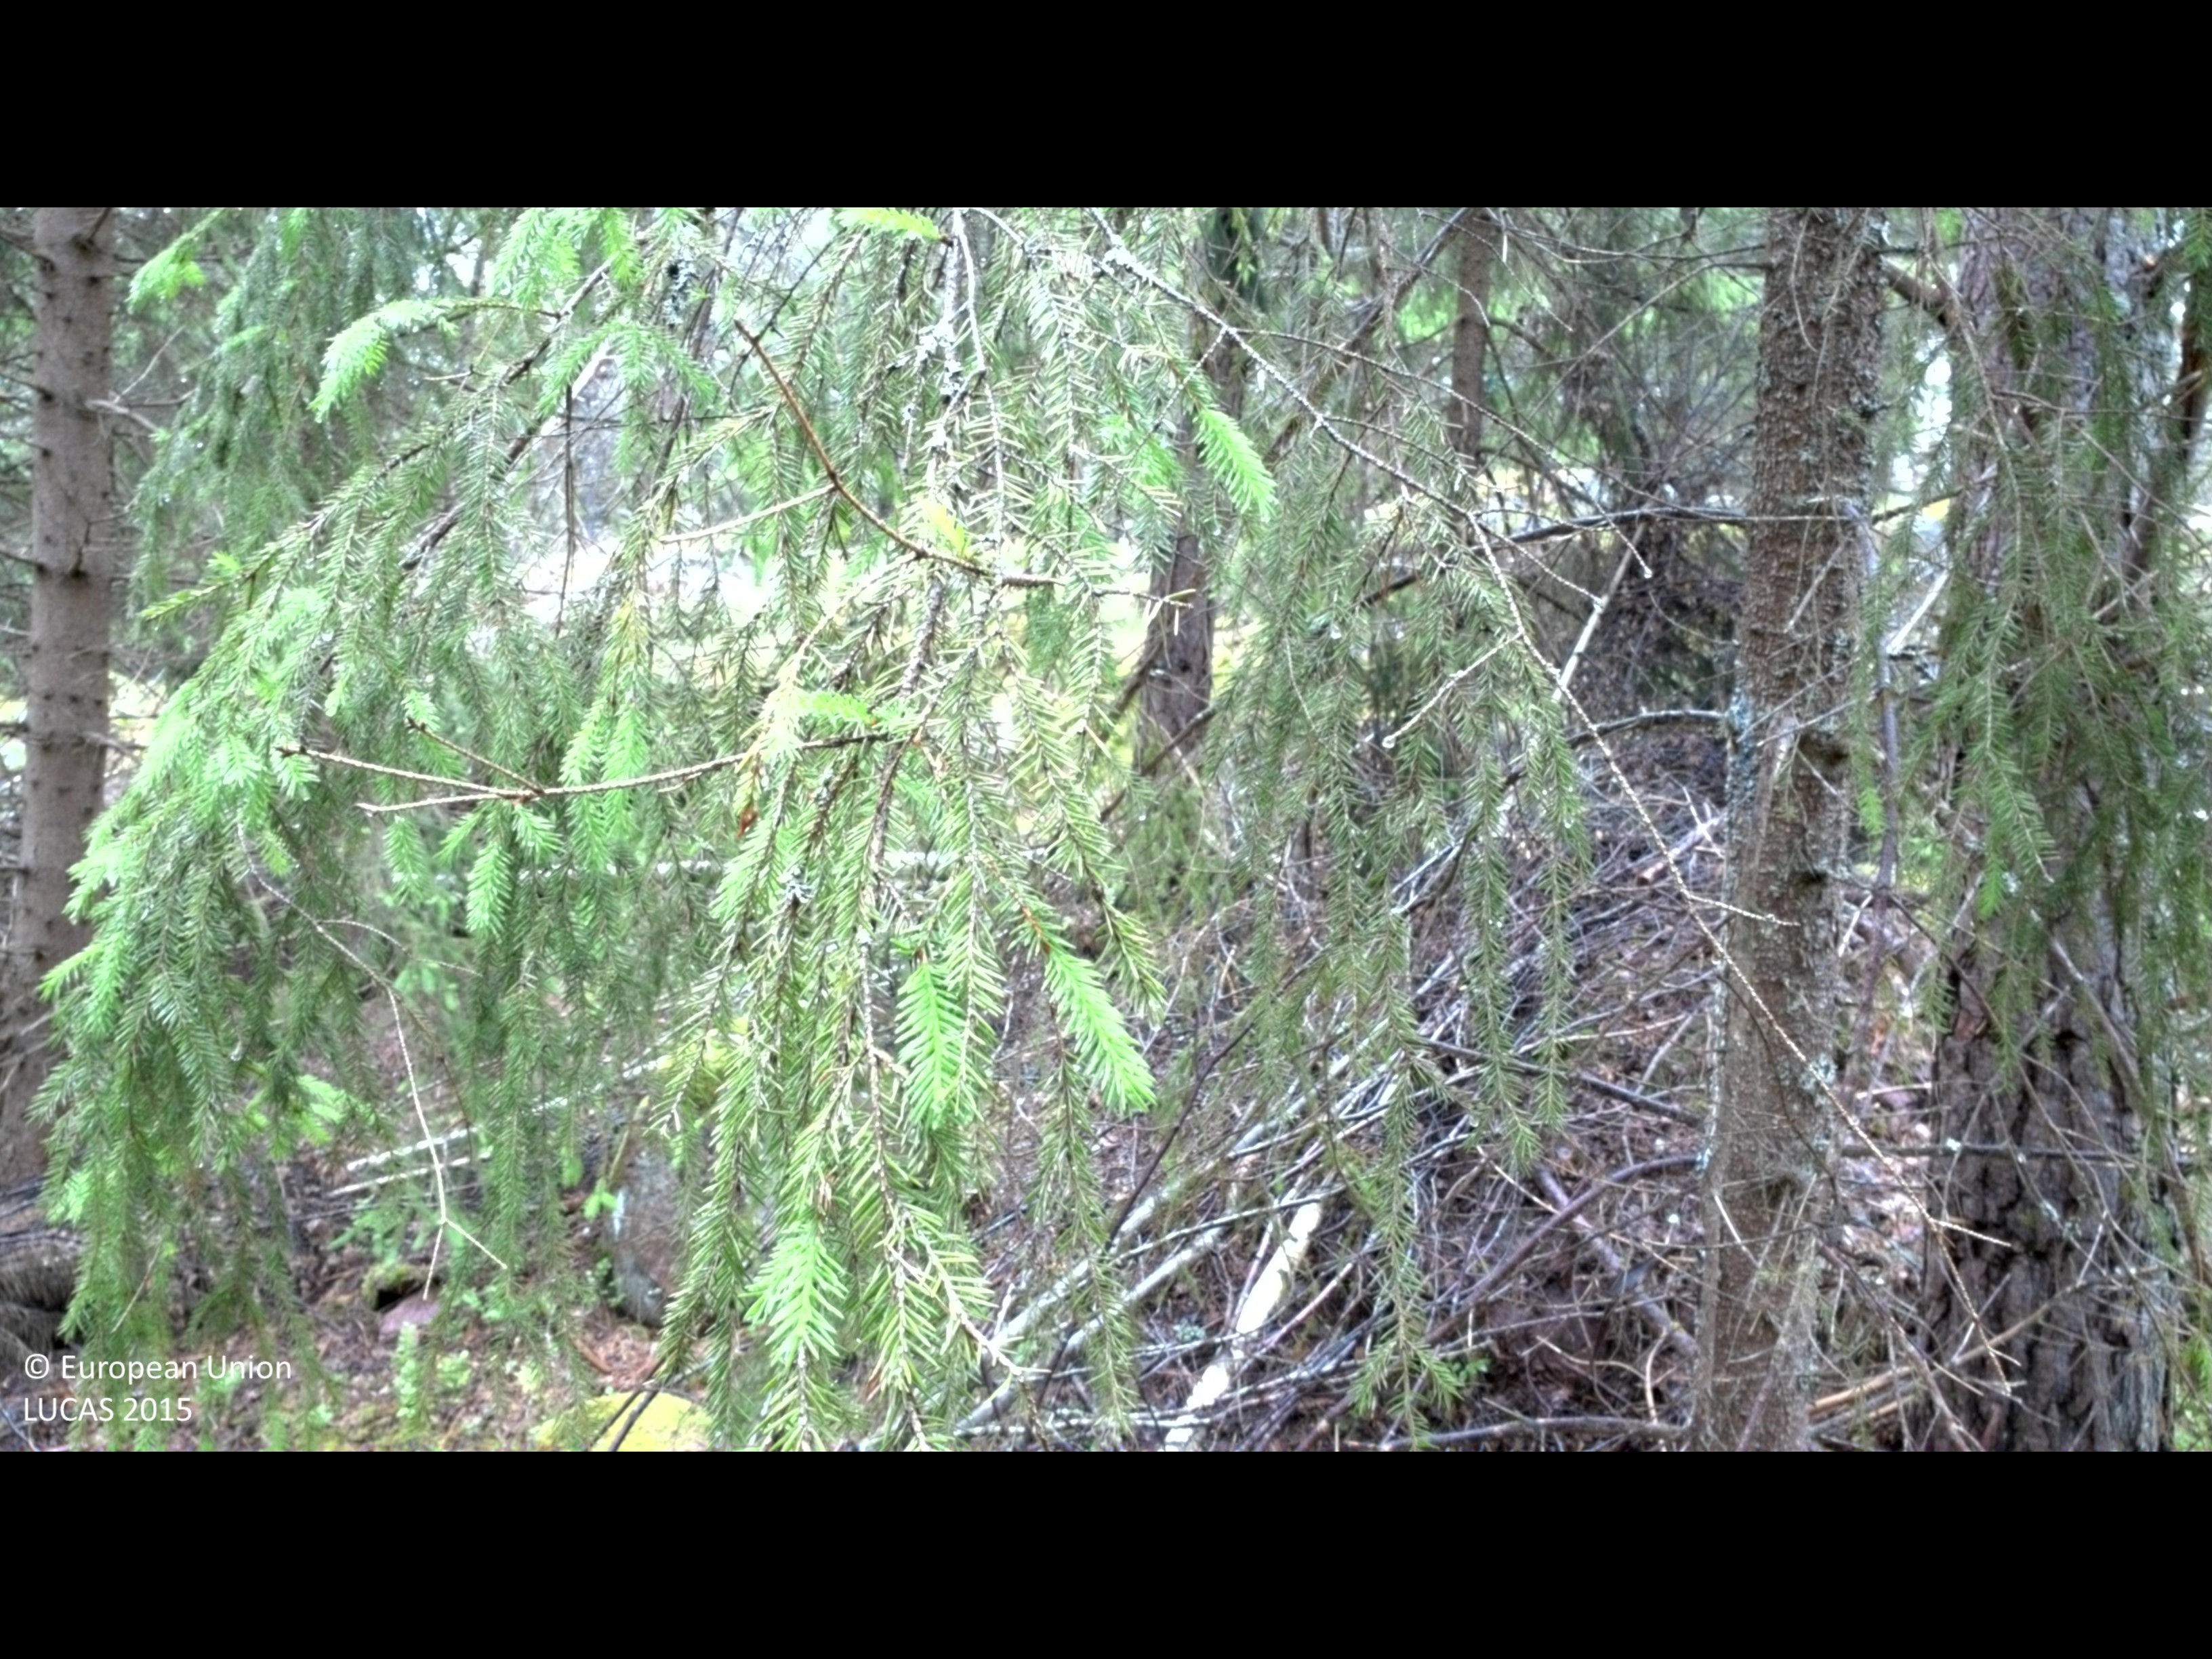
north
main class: Woodland
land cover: Spruce dominated mixed woodland
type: boreal forest
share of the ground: 50 - 75 %
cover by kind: coniferous forest trees 35 %, broadleaved forest trees 30 %, shrubs 15 %, lichens and mosses 10 %, unconsolidated bare surface 10 %
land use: Forestry
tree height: > 5 m
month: June
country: SE
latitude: 57.9635
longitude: 16.3017
